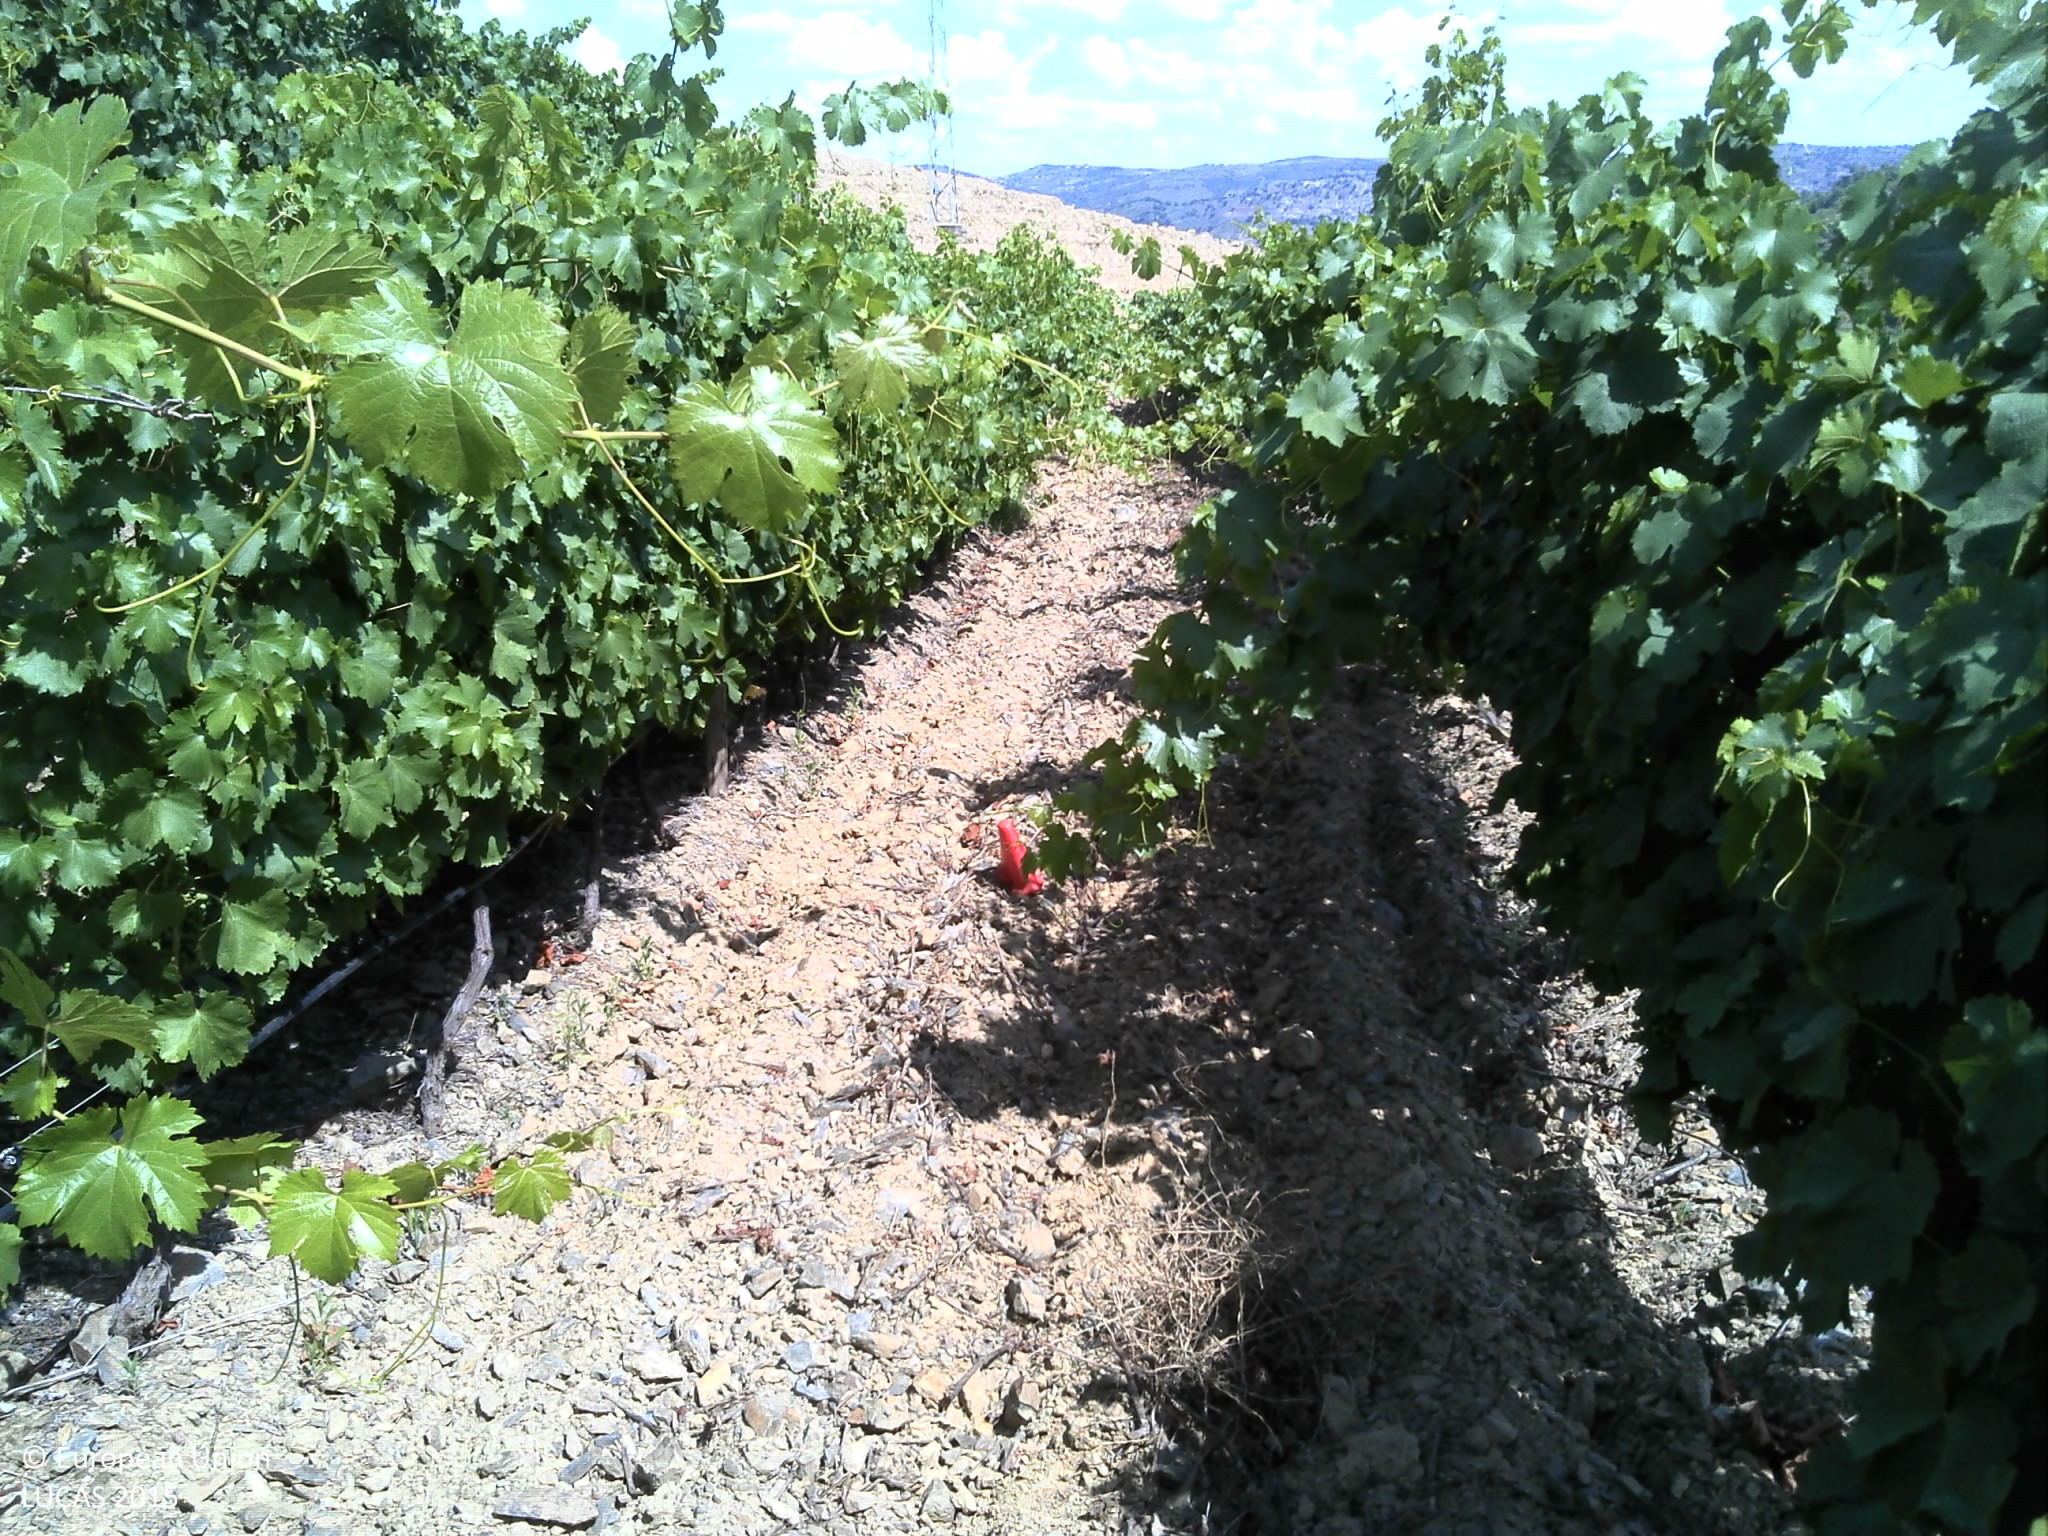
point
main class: Cropland
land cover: Vineyards
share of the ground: 10 - 25 %
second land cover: Other bare soil
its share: > 75 %
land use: Agriculture (excluding fallow land and kitchen gardens)
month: June
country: PT
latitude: 41.0690
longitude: -6.8245
